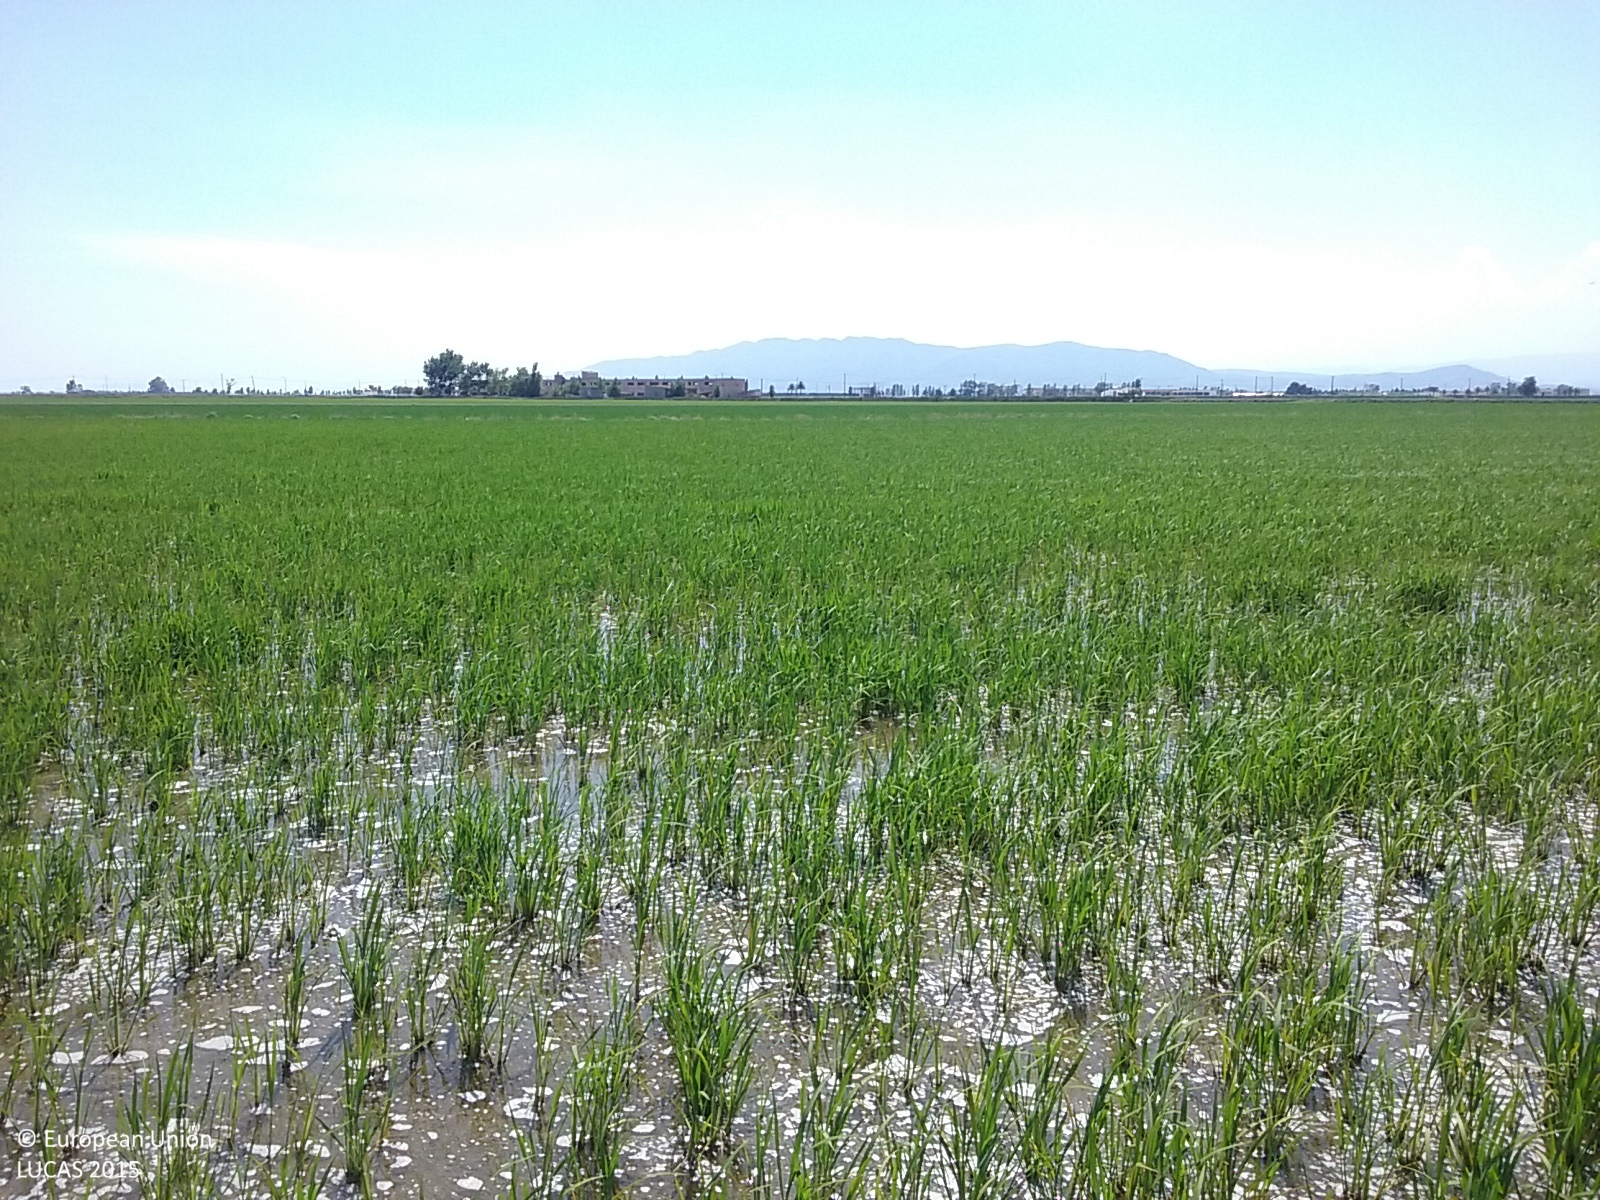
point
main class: Cropland
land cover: Rice
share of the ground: > 75 %
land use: Agriculture (excluding fallow land and kitchen gardens)
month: June
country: ES
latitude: 40.6830
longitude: 0.7313
